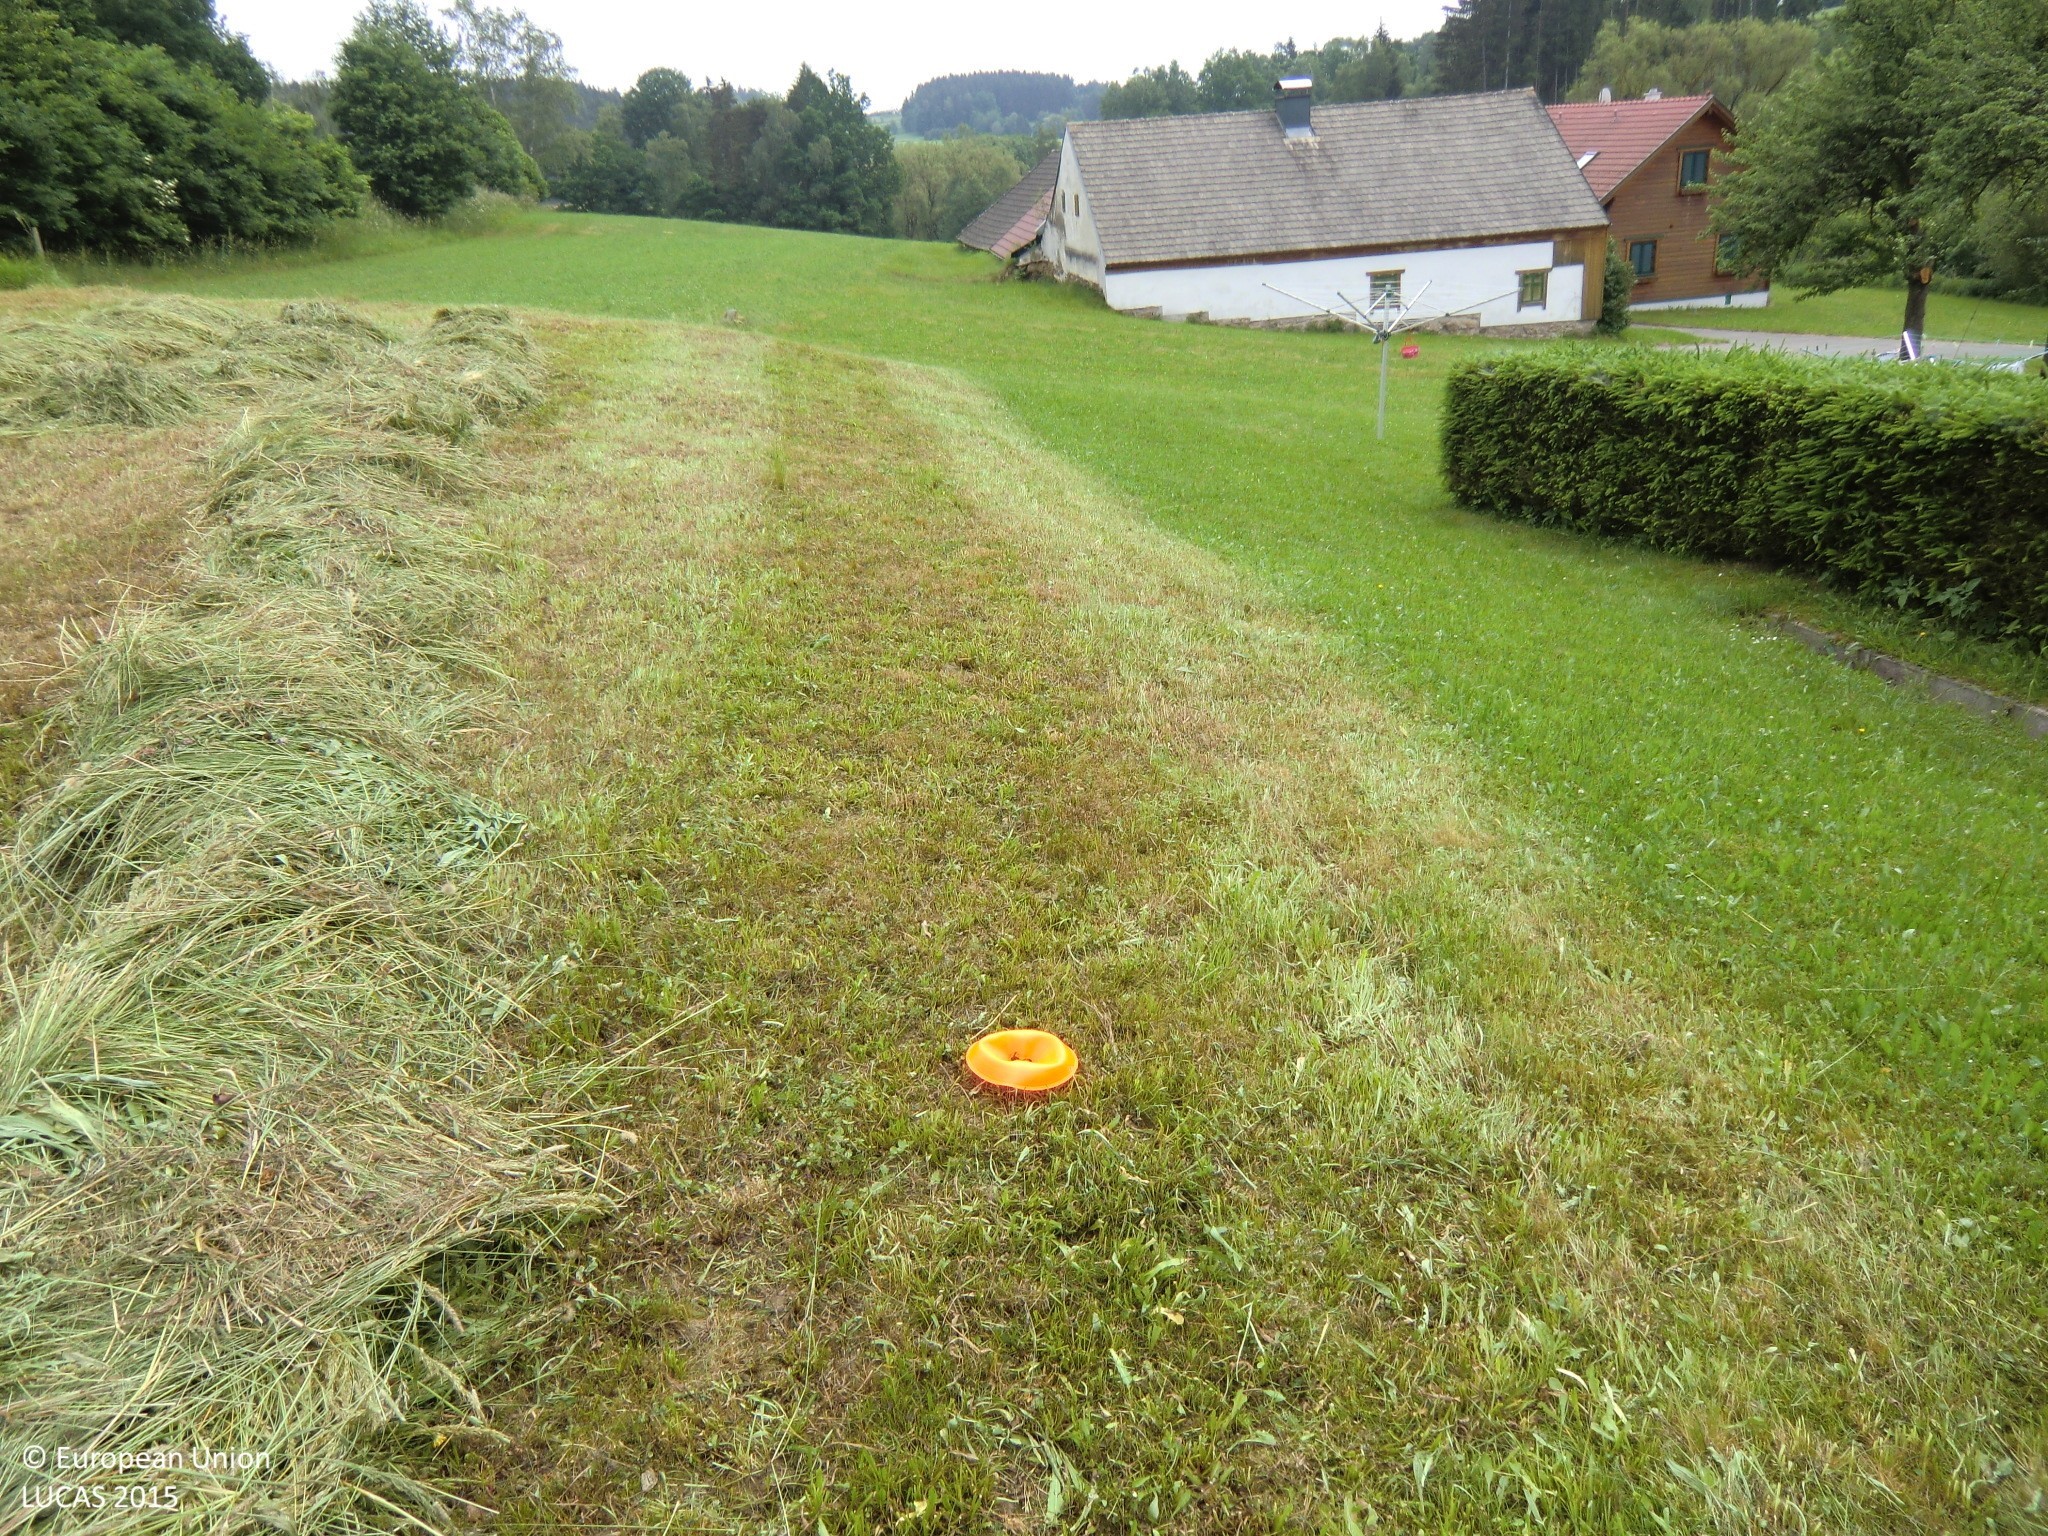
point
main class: Grassland
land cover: Grassland without tree/shrub cover
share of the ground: > 75 %
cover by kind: herbaceous plants 100 %
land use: Agriculture (excluding fallow land and kitchen gardens)
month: June
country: AT
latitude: 48.6313
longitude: 15.0358
